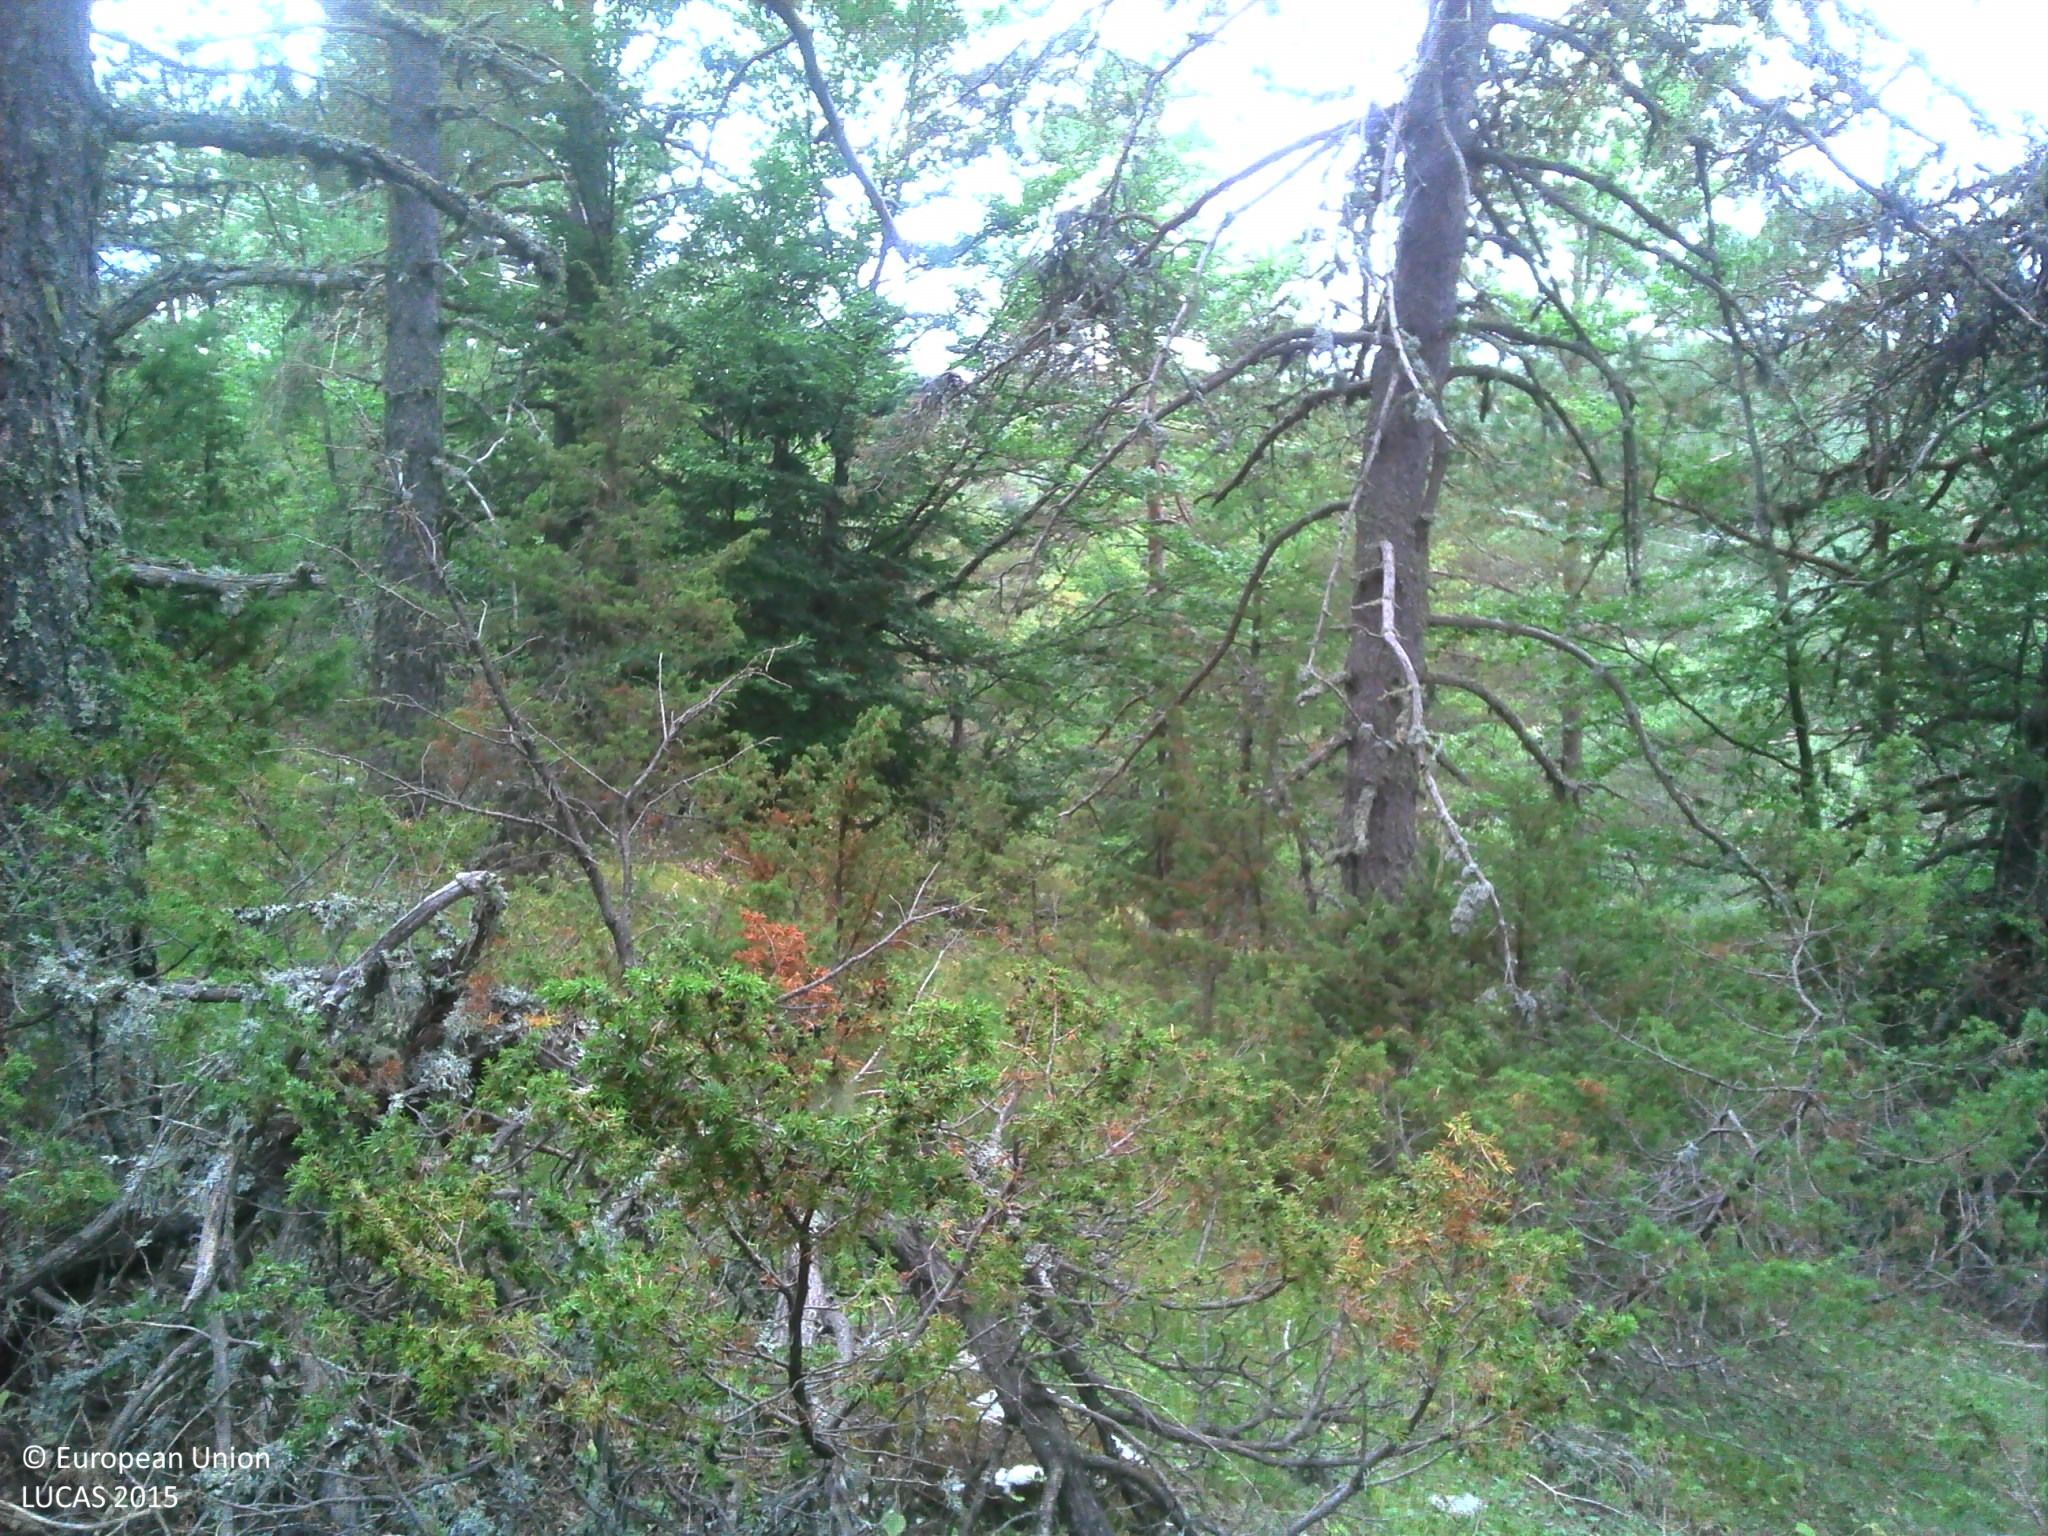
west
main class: Woodland
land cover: Pine dominated coniferous woodland
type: alpine coniferous forest
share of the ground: 50 - 75 %
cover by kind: coniferous forest trees 60 %, herbaceous plants 20 %, broadleaved forest trees 10 %, lichens and mosses 10 %
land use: Forestry
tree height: > 5 m
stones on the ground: 10 - 25 %
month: August
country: FR
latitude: 44.0602
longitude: 6.5992
